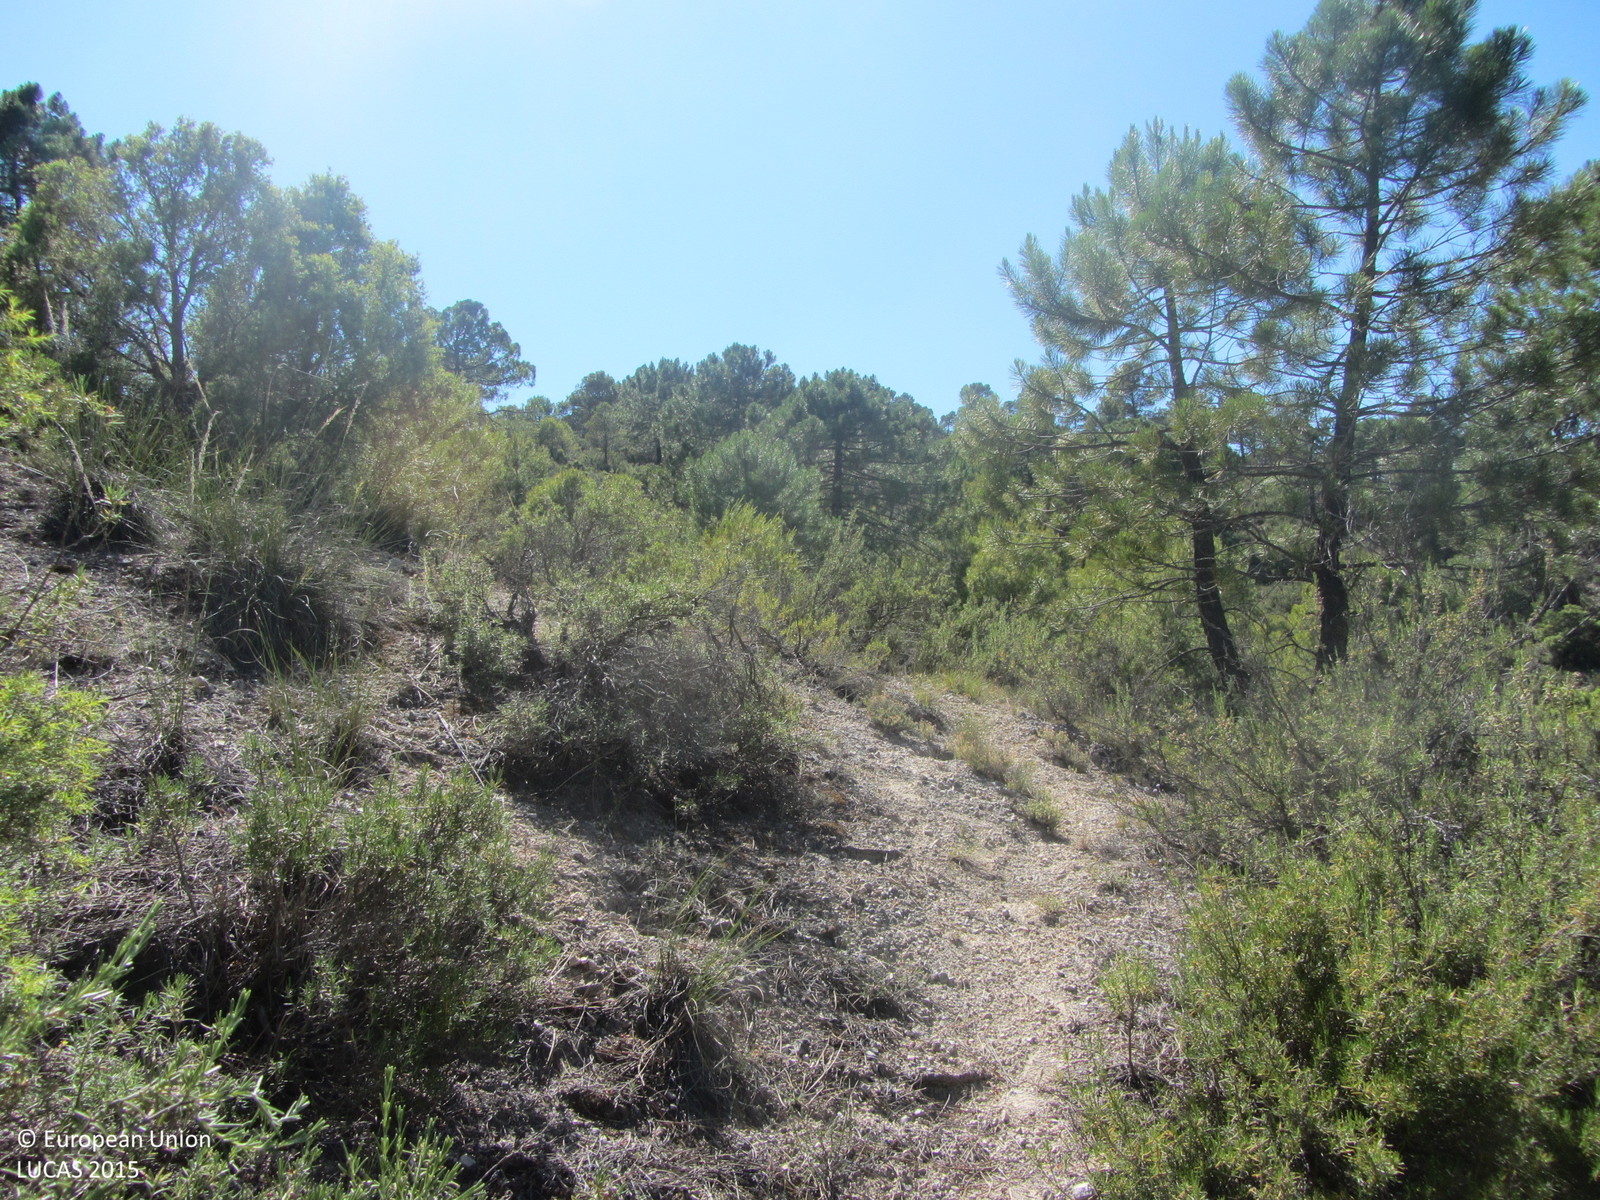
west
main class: Woodland
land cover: Pine dominated coniferous woodland
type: coniferous forest of the mediterranean region
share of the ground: 25 - 50 %
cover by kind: coniferous forest trees 35 %, shrubs 35 %, unconsolidated bare surface 20 %, herbaceous plants 10 %
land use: Forestry
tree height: > 5 m
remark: Clear cut
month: June
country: ES
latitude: 38.4104
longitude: -2.5845
